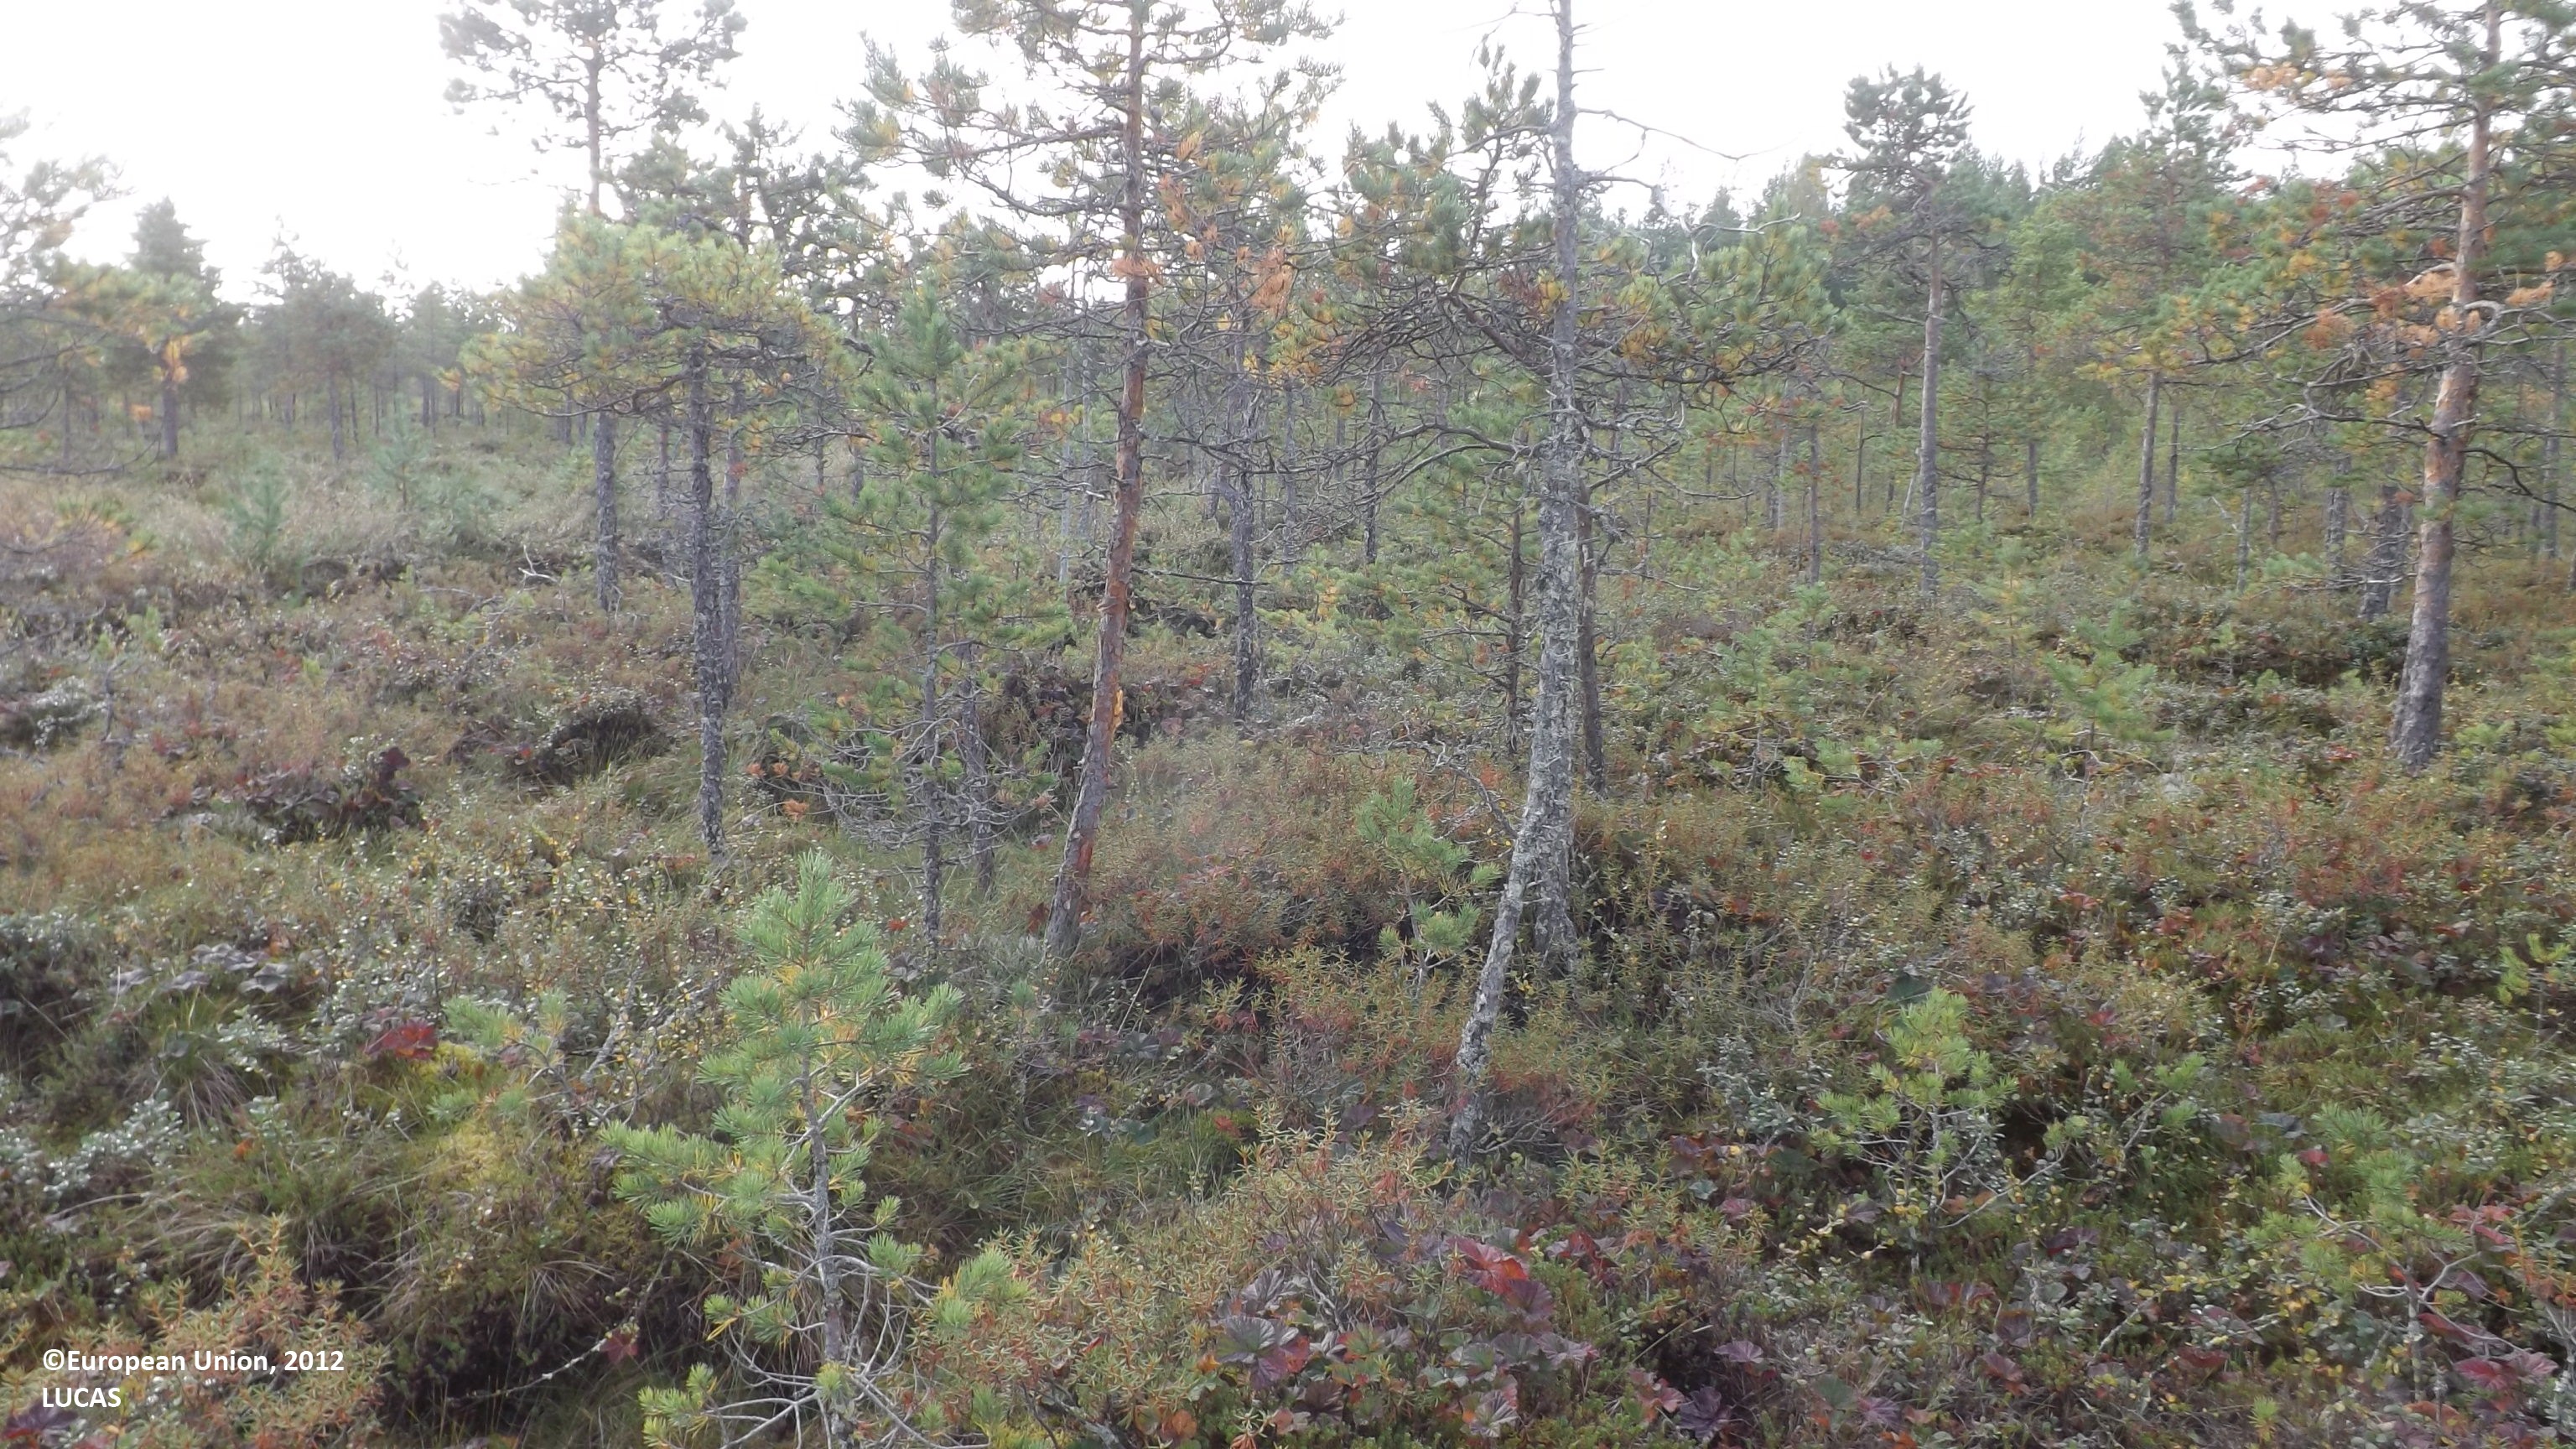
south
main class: Woodland
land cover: Pine dominated coniferous woodland
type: mire and swamp forests
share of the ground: 10 - 25 %
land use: Forestry
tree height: < 5 m
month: August
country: FI
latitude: 63.8617
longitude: 23.6309
